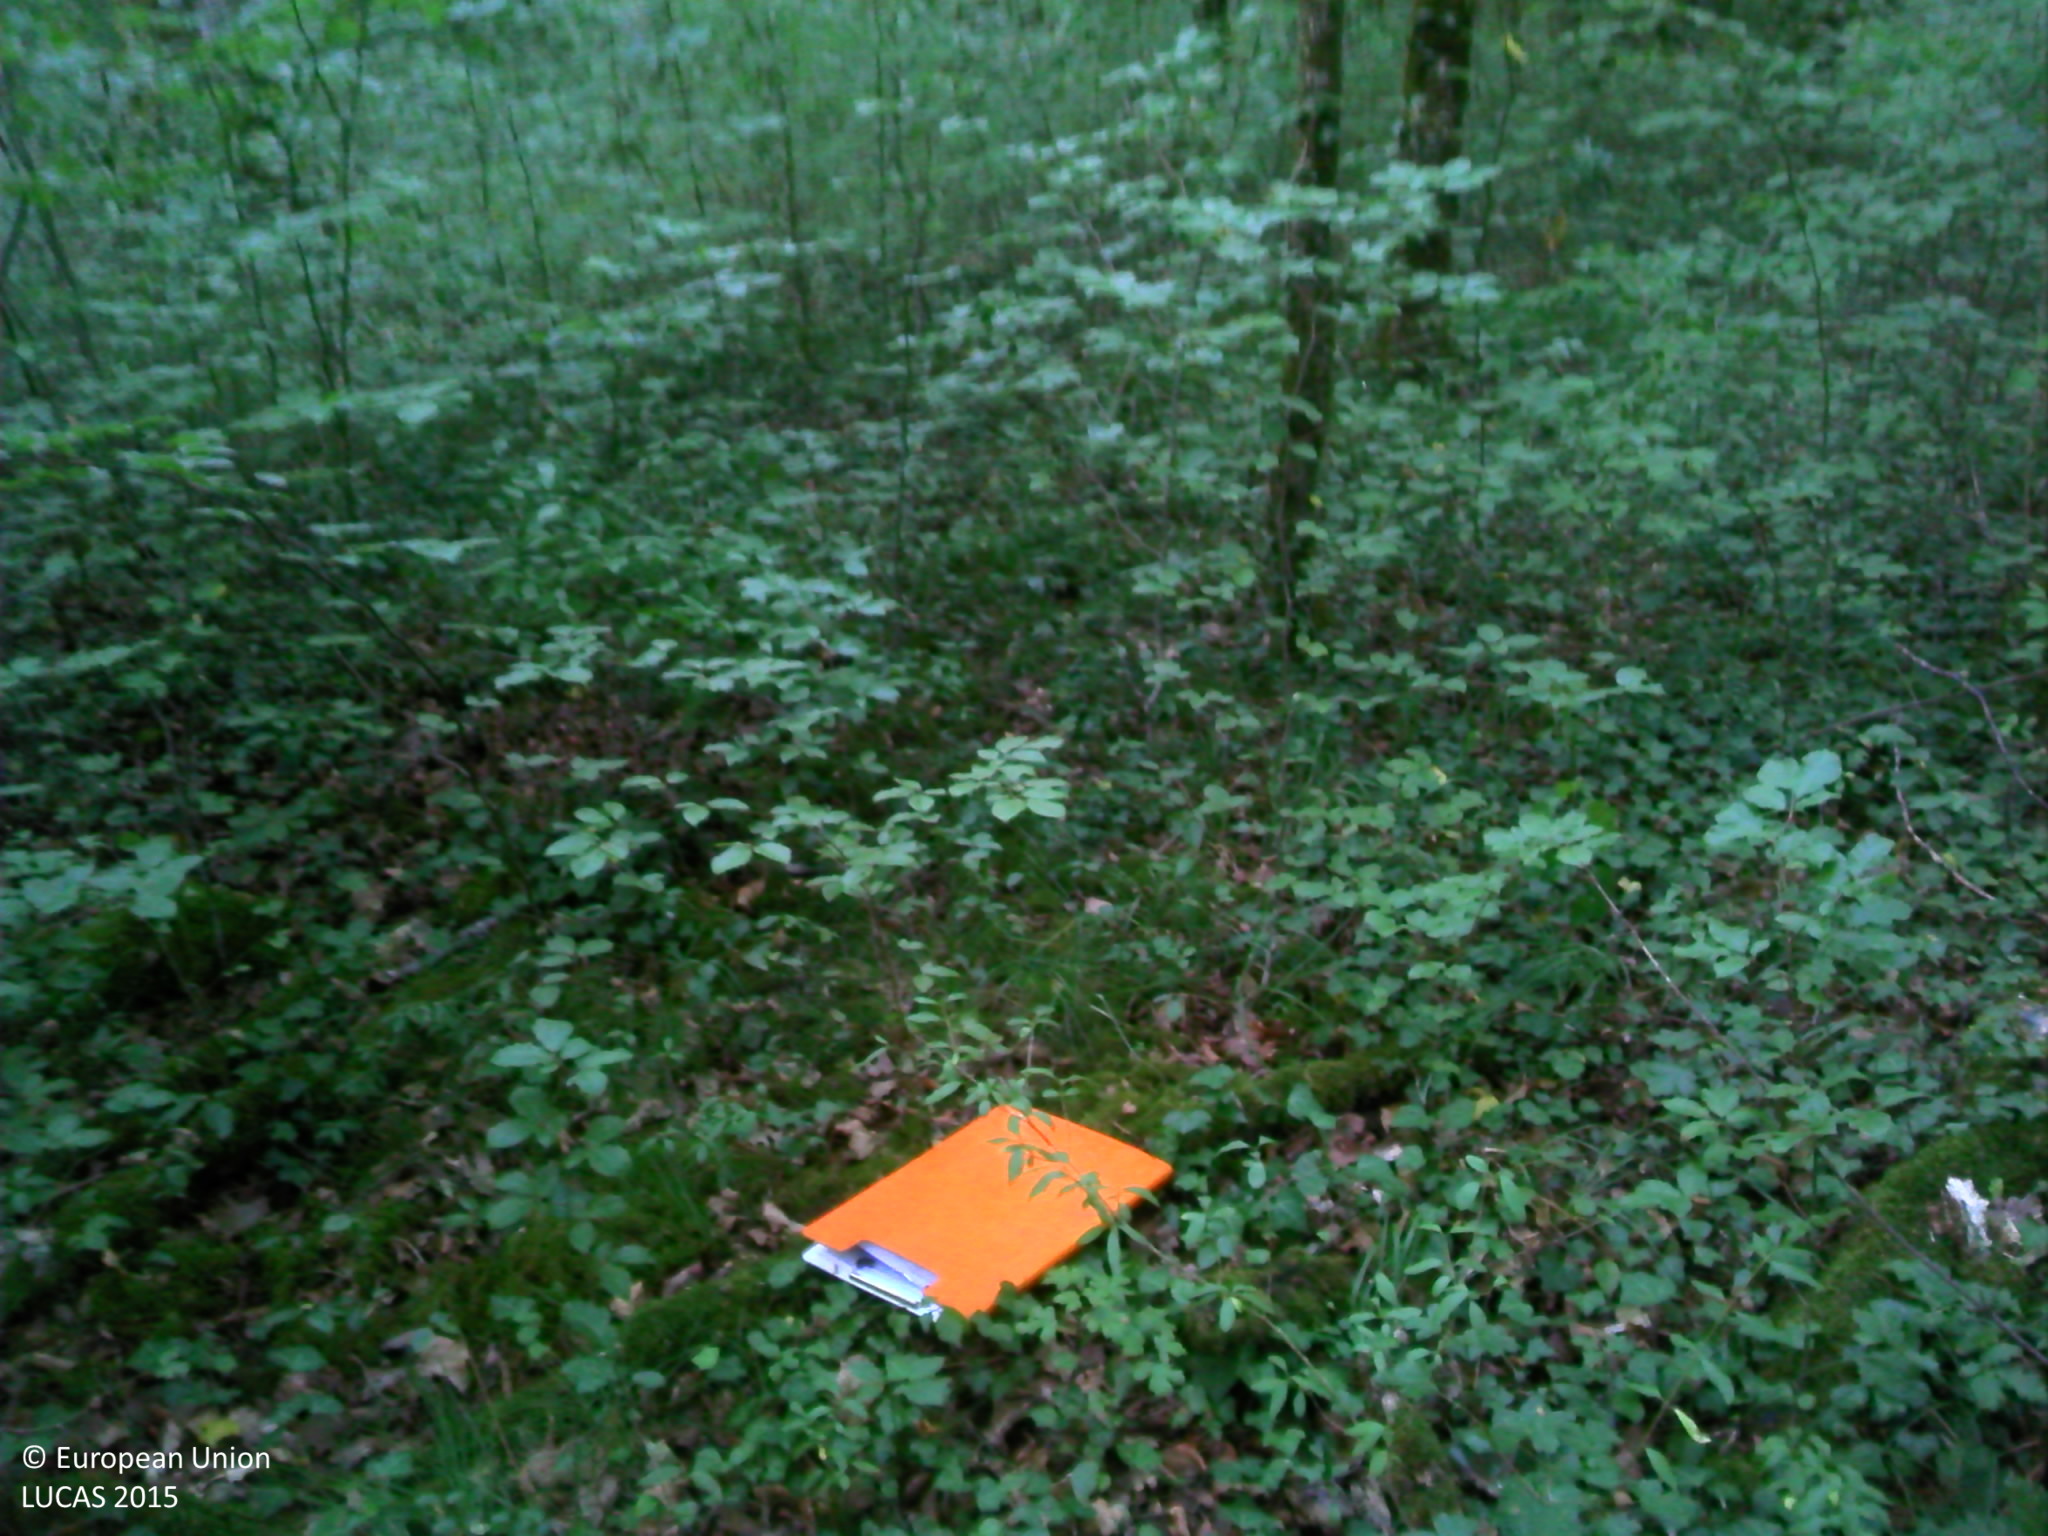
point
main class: Woodland
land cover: Broadleaved woodland
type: acidophilous oak and oak-birch forest
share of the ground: > 75 %
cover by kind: broadleaved forest trees 85 %, herbaceous plants 10 %, lichens and mosses 5 %
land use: Forestry
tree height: > 5 m
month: July
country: FR
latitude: 47.8751
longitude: 4.9854
